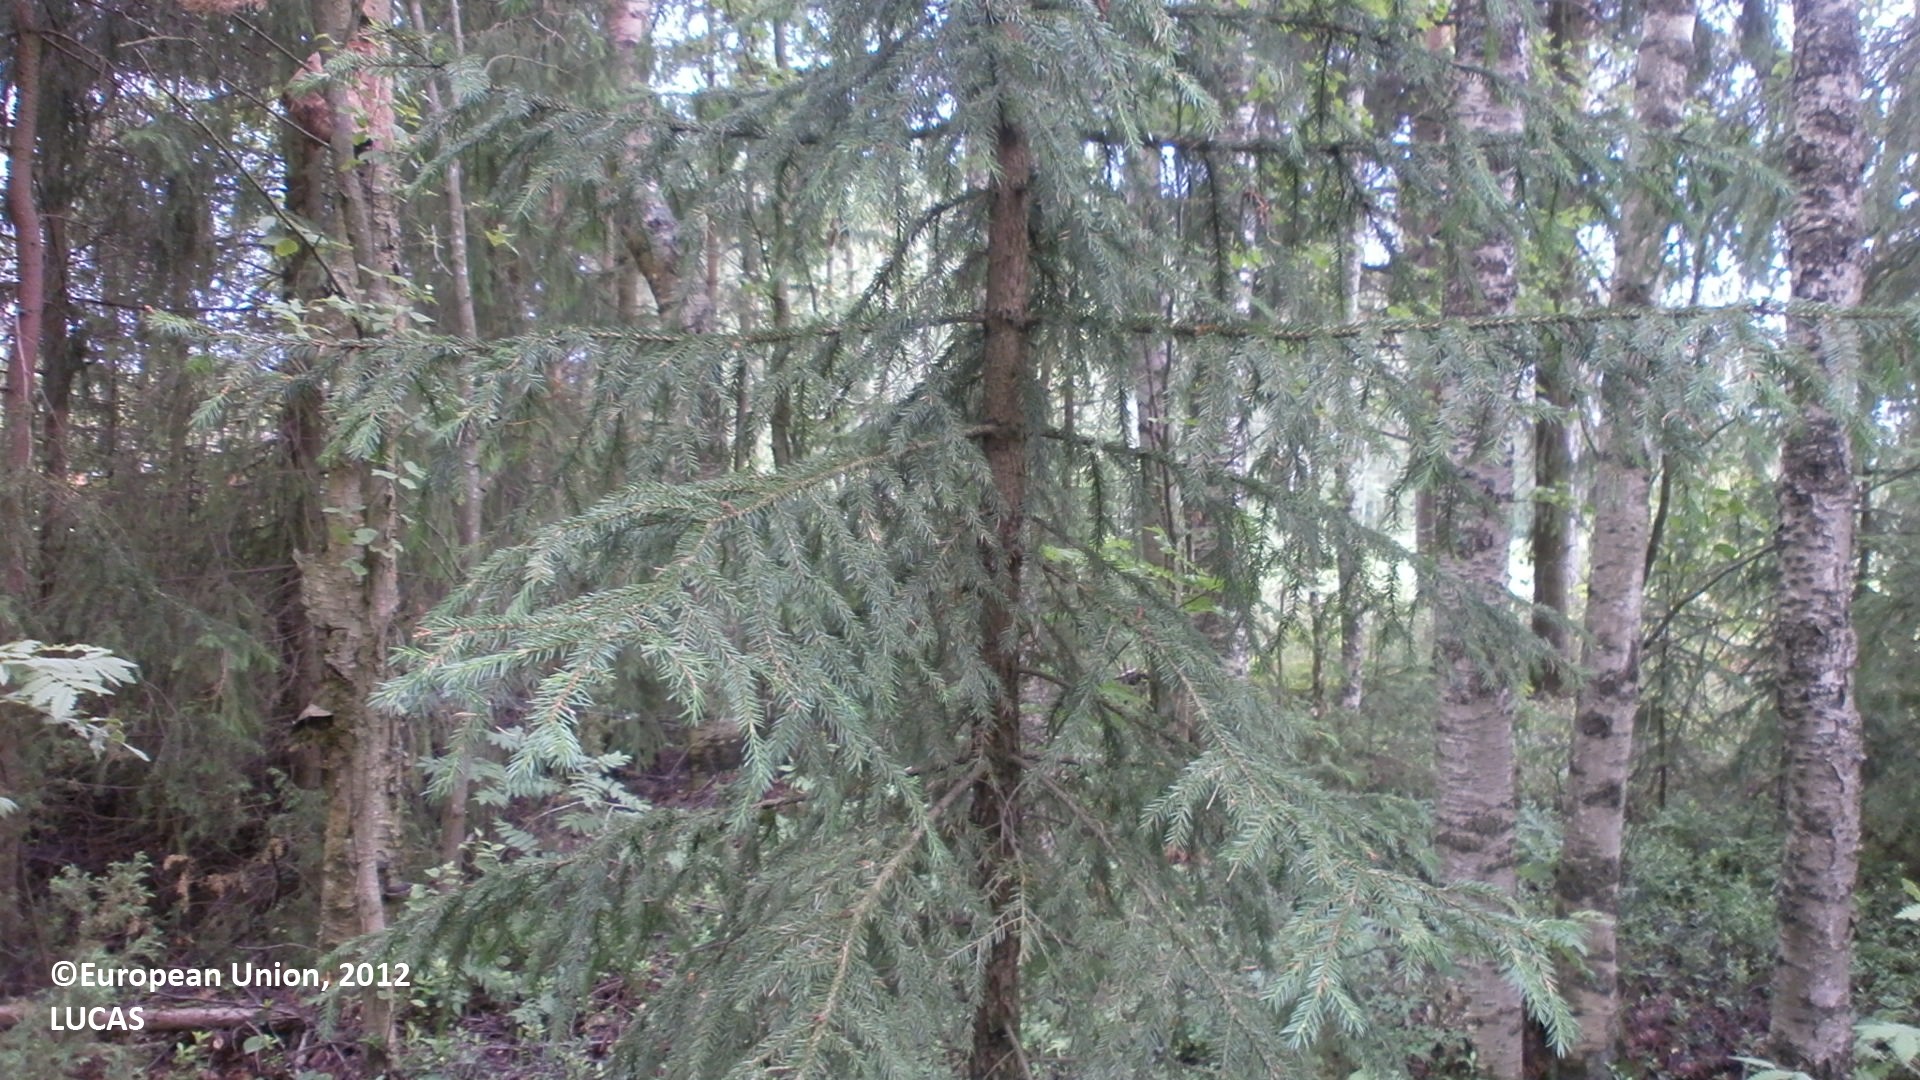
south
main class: Woodland
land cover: Spruce dominated mixed woodland
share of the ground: > 75 %
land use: Forestry
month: July
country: FI
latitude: 64.7794
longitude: 24.6878
